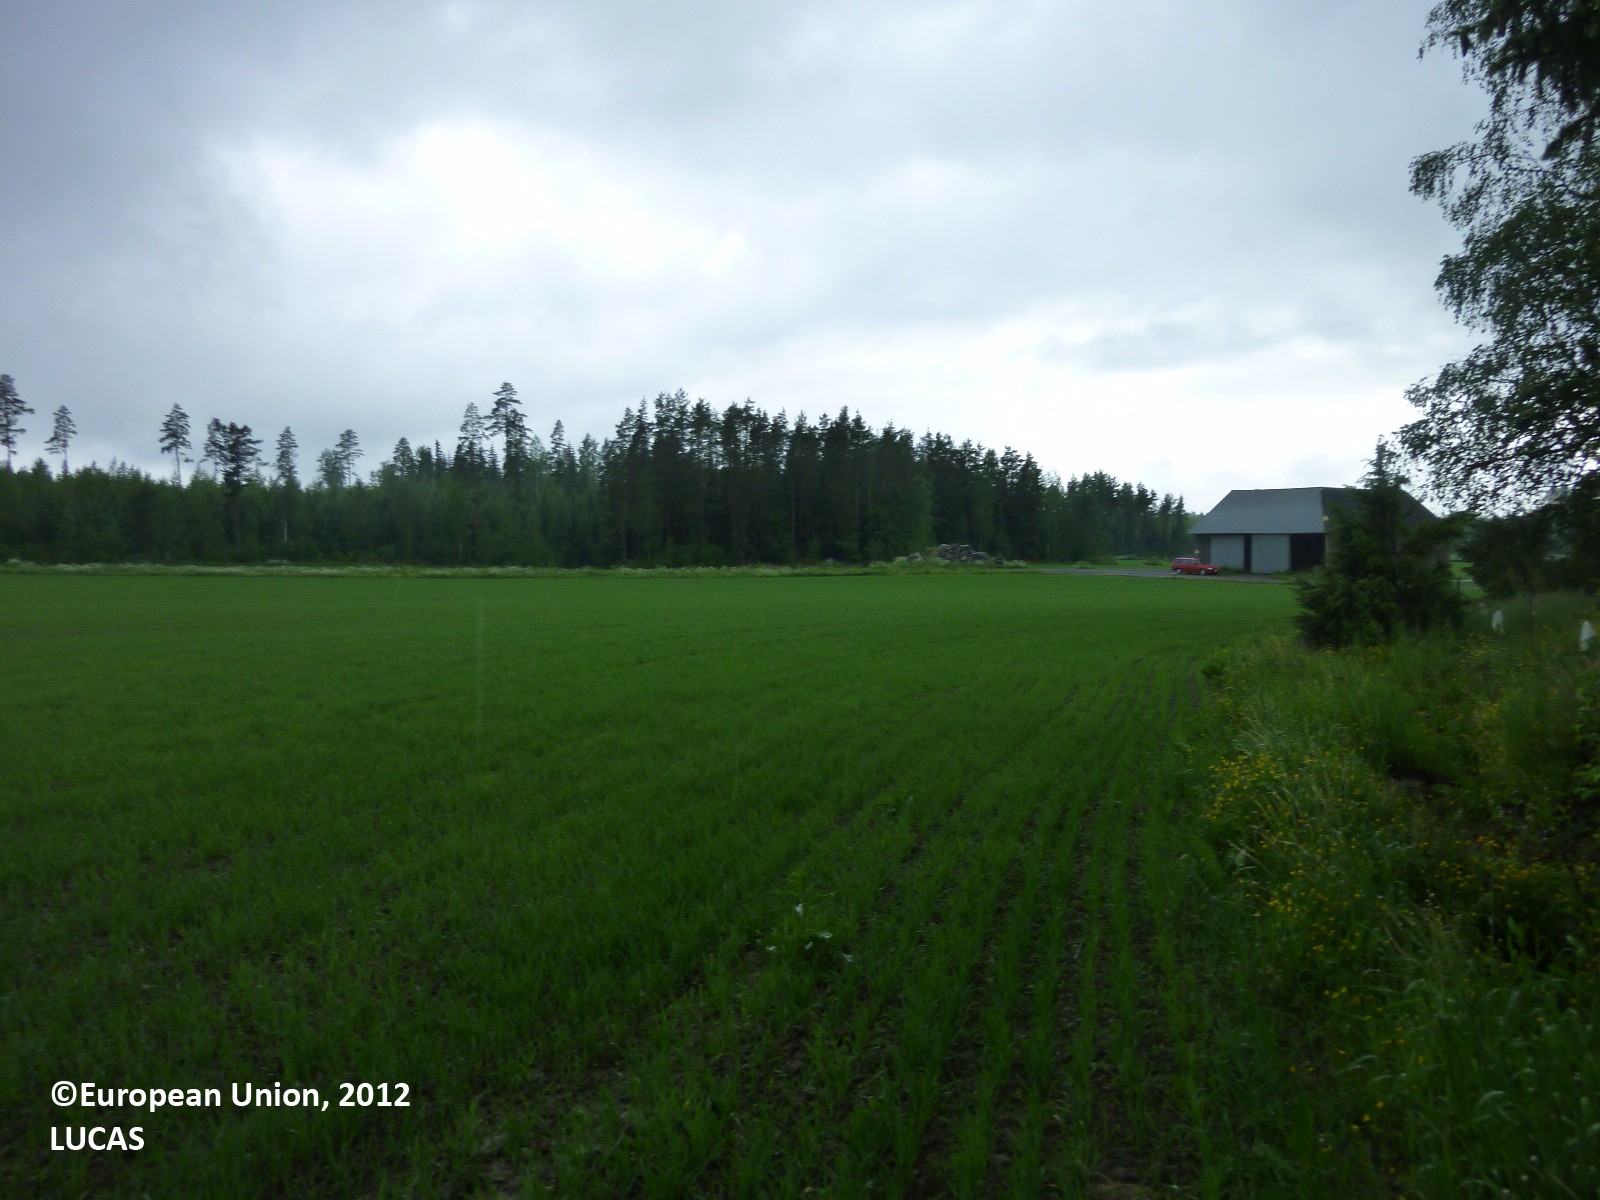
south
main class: Cropland
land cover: Oats
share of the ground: > 75 %
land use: Agriculture (excluding fallow land and kitchen gardens)
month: June
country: FI
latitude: 61.5387
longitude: 22.3058
